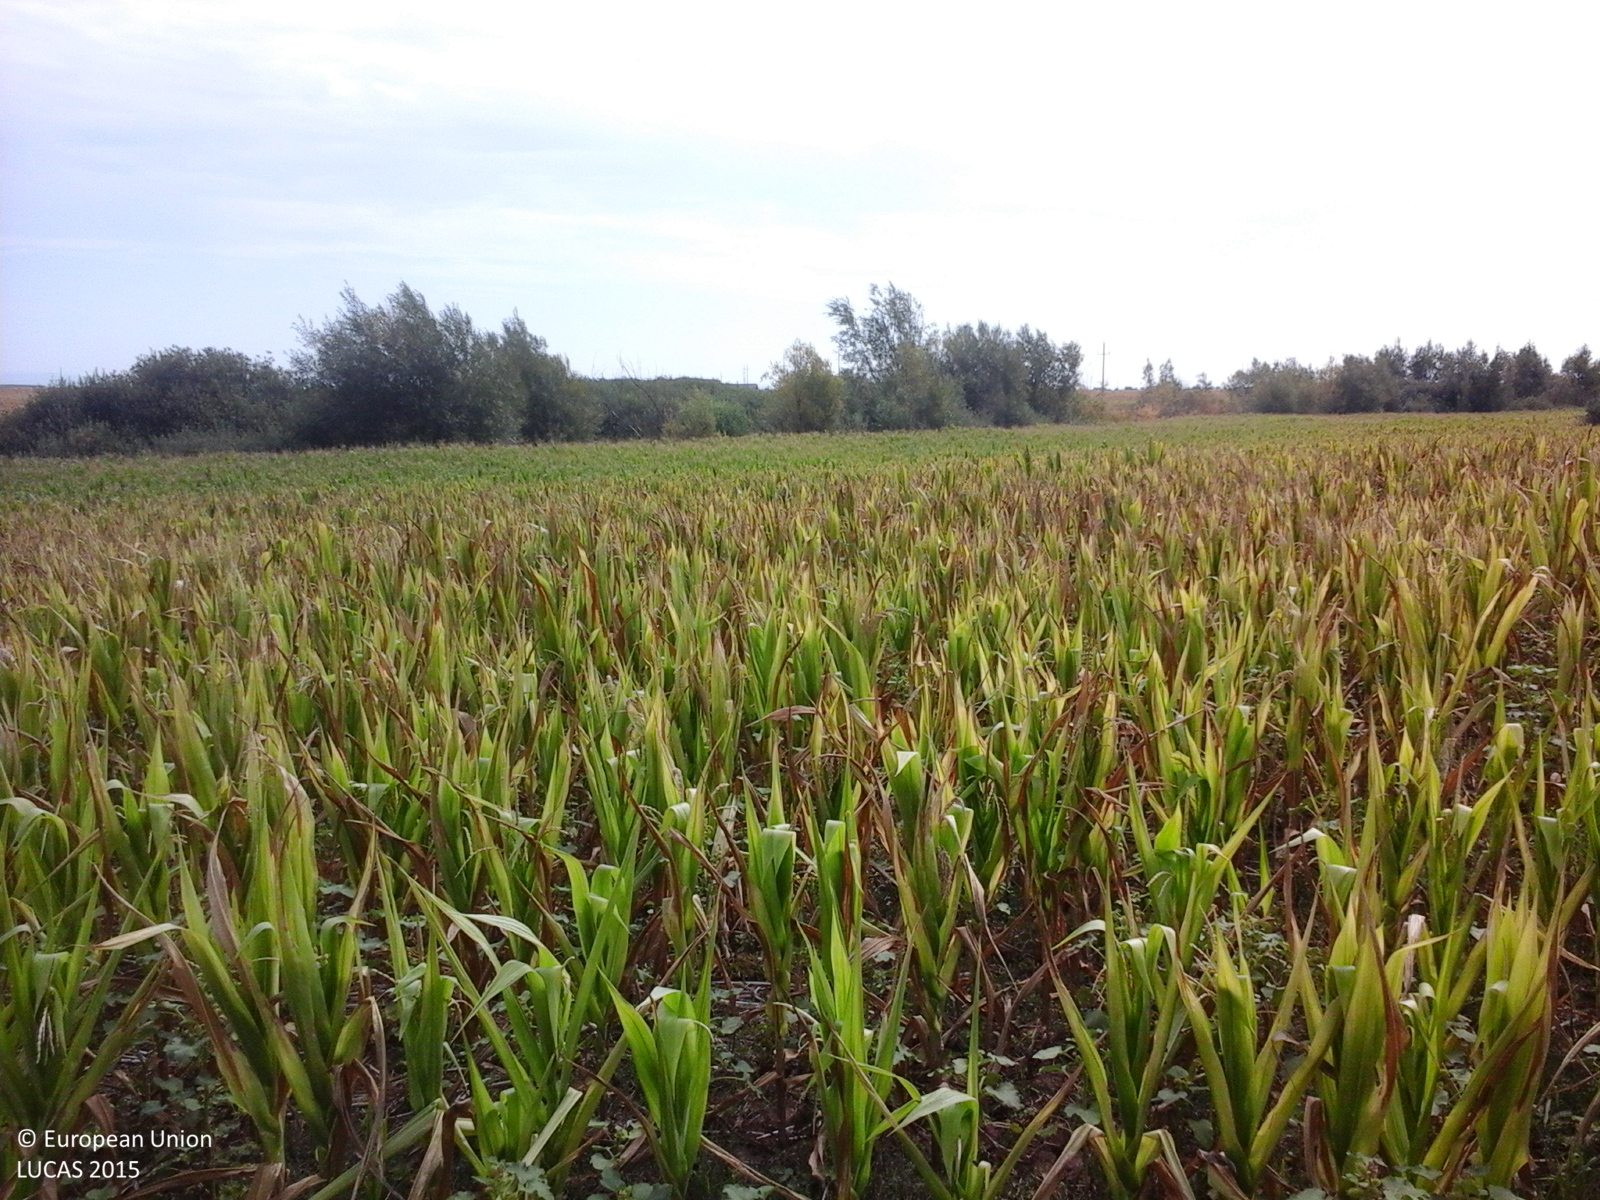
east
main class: Cropland
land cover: Maize
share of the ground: > 75 %
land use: Agriculture (excluding fallow land and kitchen gardens)
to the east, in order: Maize; Abandoned hedges; Ditches and canals; Abandoned hedges; Maize; Electric lines; Maize
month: August
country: RO
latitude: 46.1286
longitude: 21.3326
